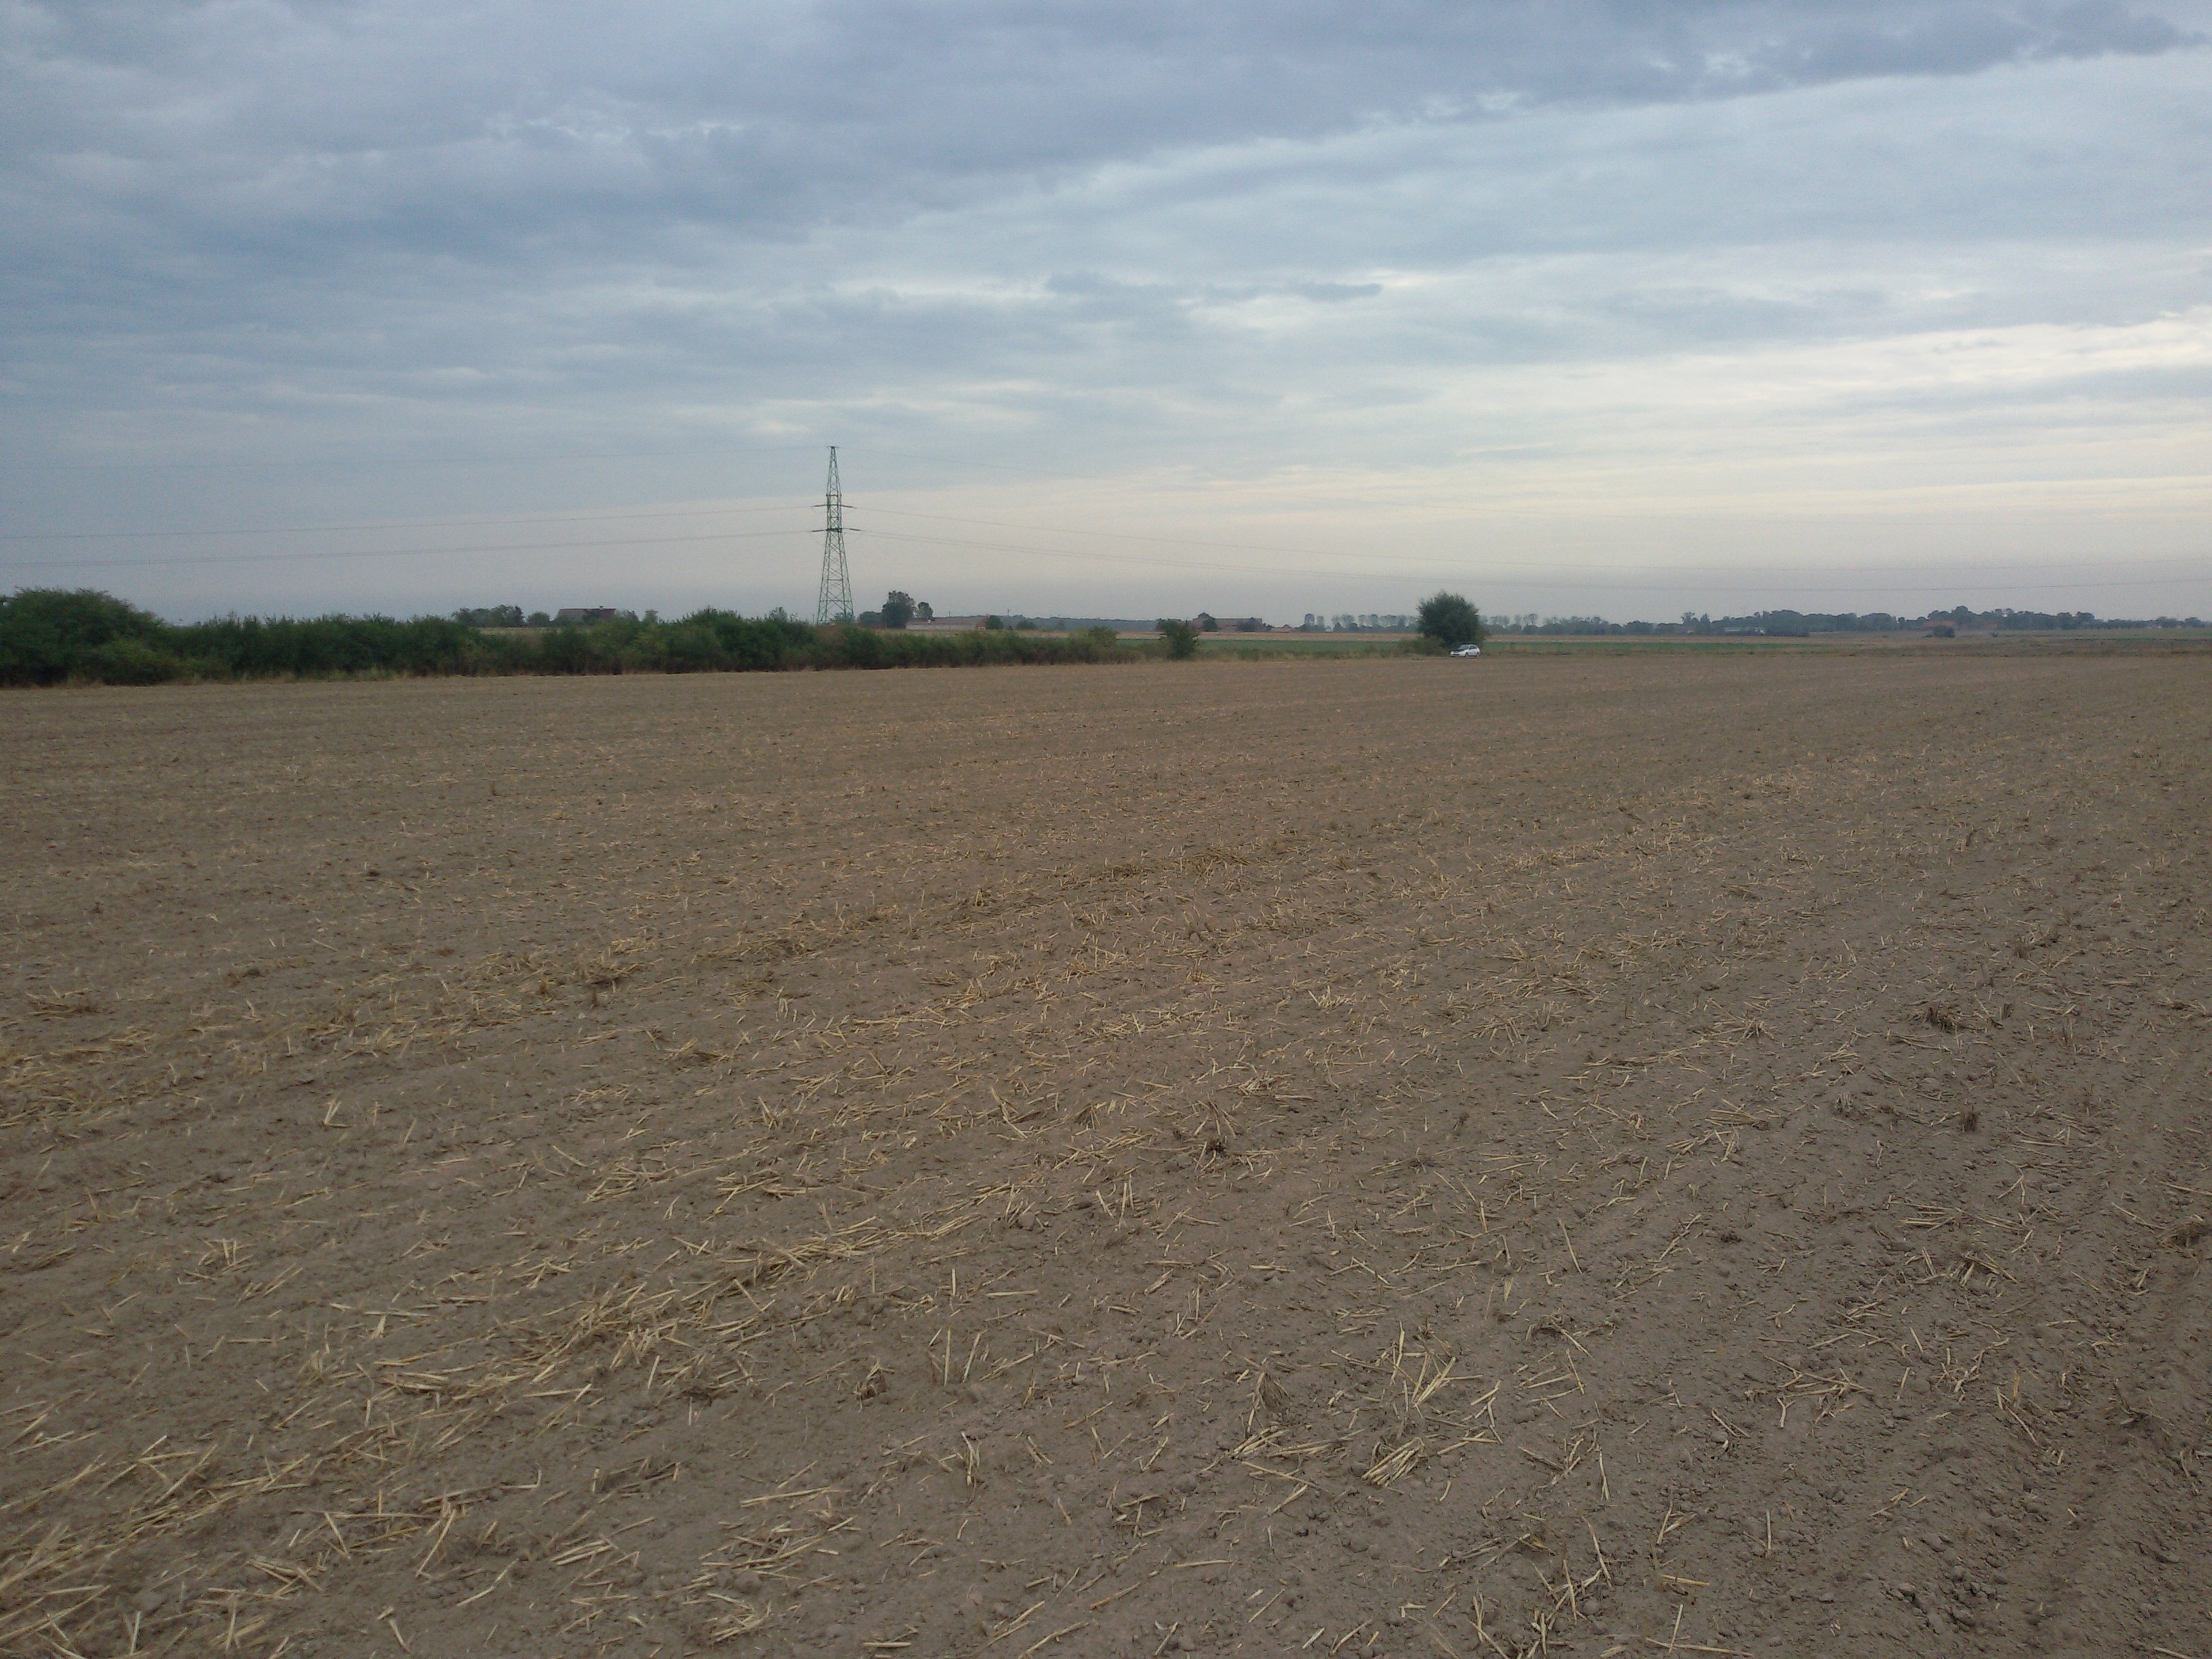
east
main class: Cropland
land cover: Common wheat
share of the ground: < 10 %
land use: Agriculture (excluding fallow land and kitchen gardens)
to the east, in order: Common wheat; Shrubland with sparse tree cover; Ditches and canals; Shrubland with sparse tree cover; Other fresh vegetables; Electric lines; Other fresh vegetables; Potatoes
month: August
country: PL
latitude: 51.7718
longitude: 17.8843
